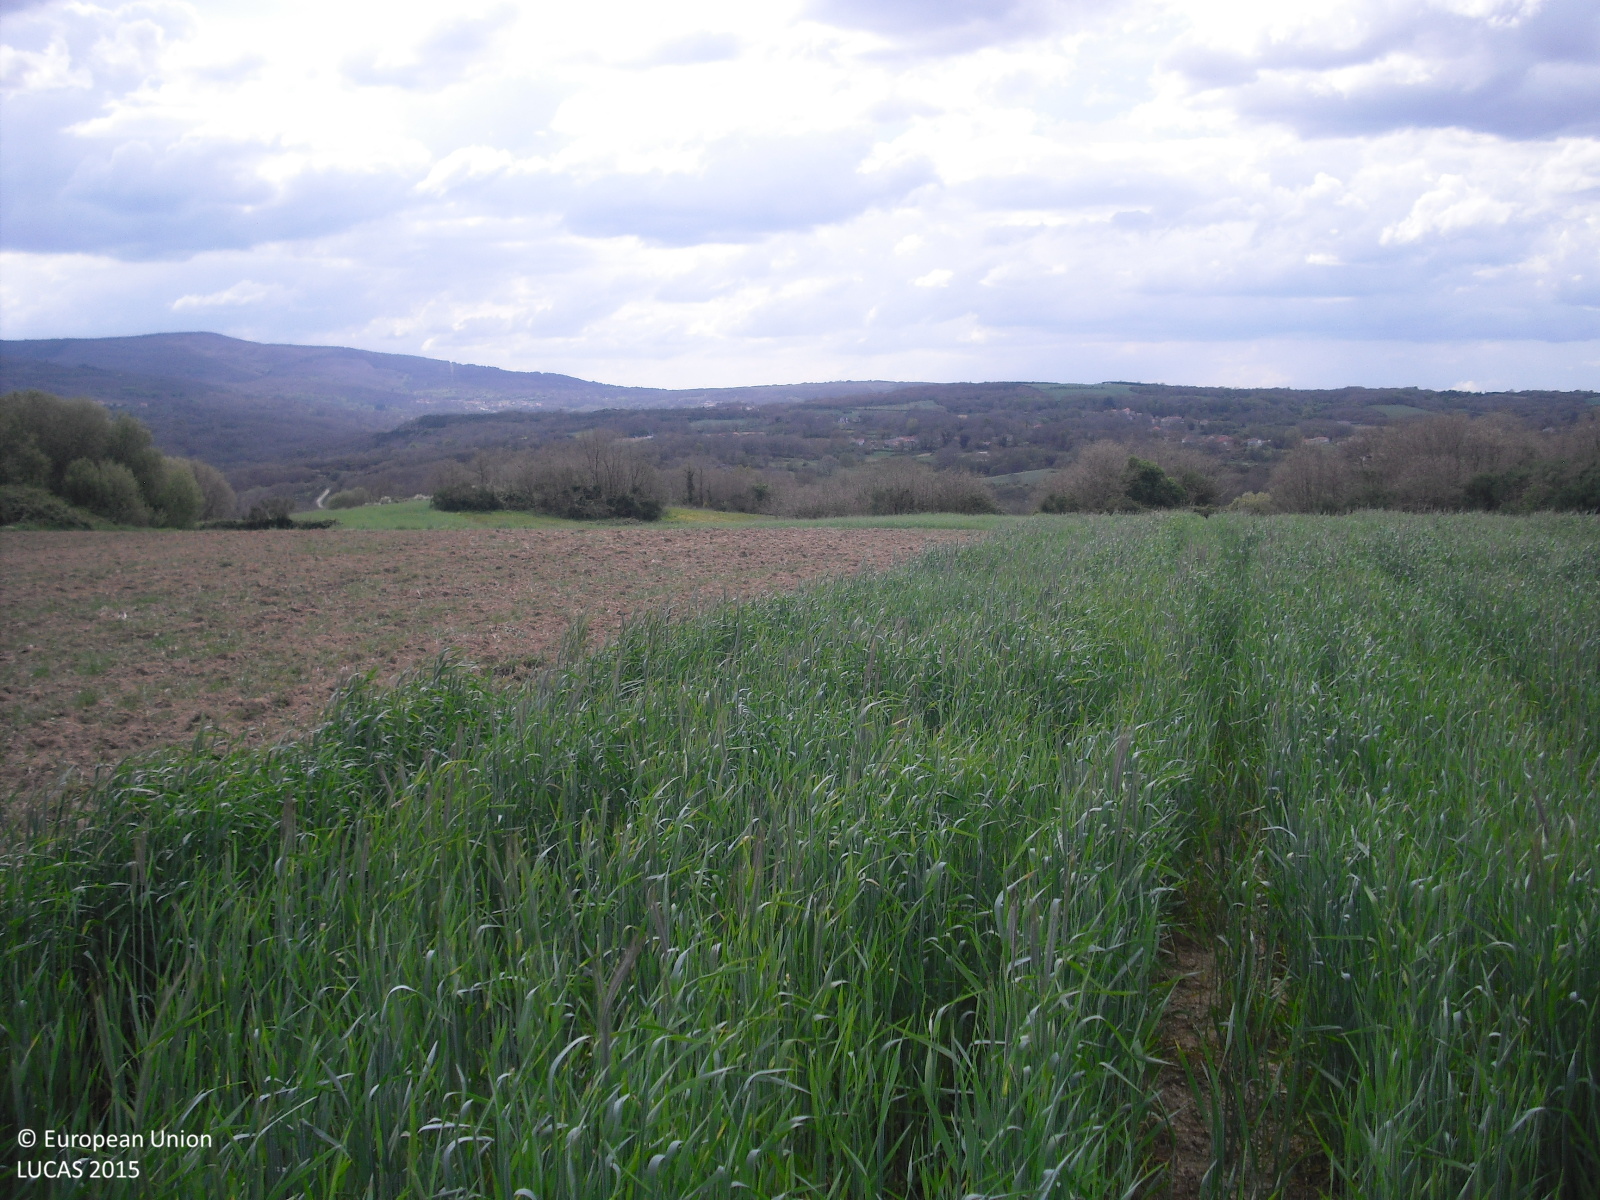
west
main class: Cropland
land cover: Rye
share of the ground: > 75 %
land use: Agriculture (excluding fallow land and kitchen gardens)
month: April
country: ES
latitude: 41.9973
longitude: -7.7304
